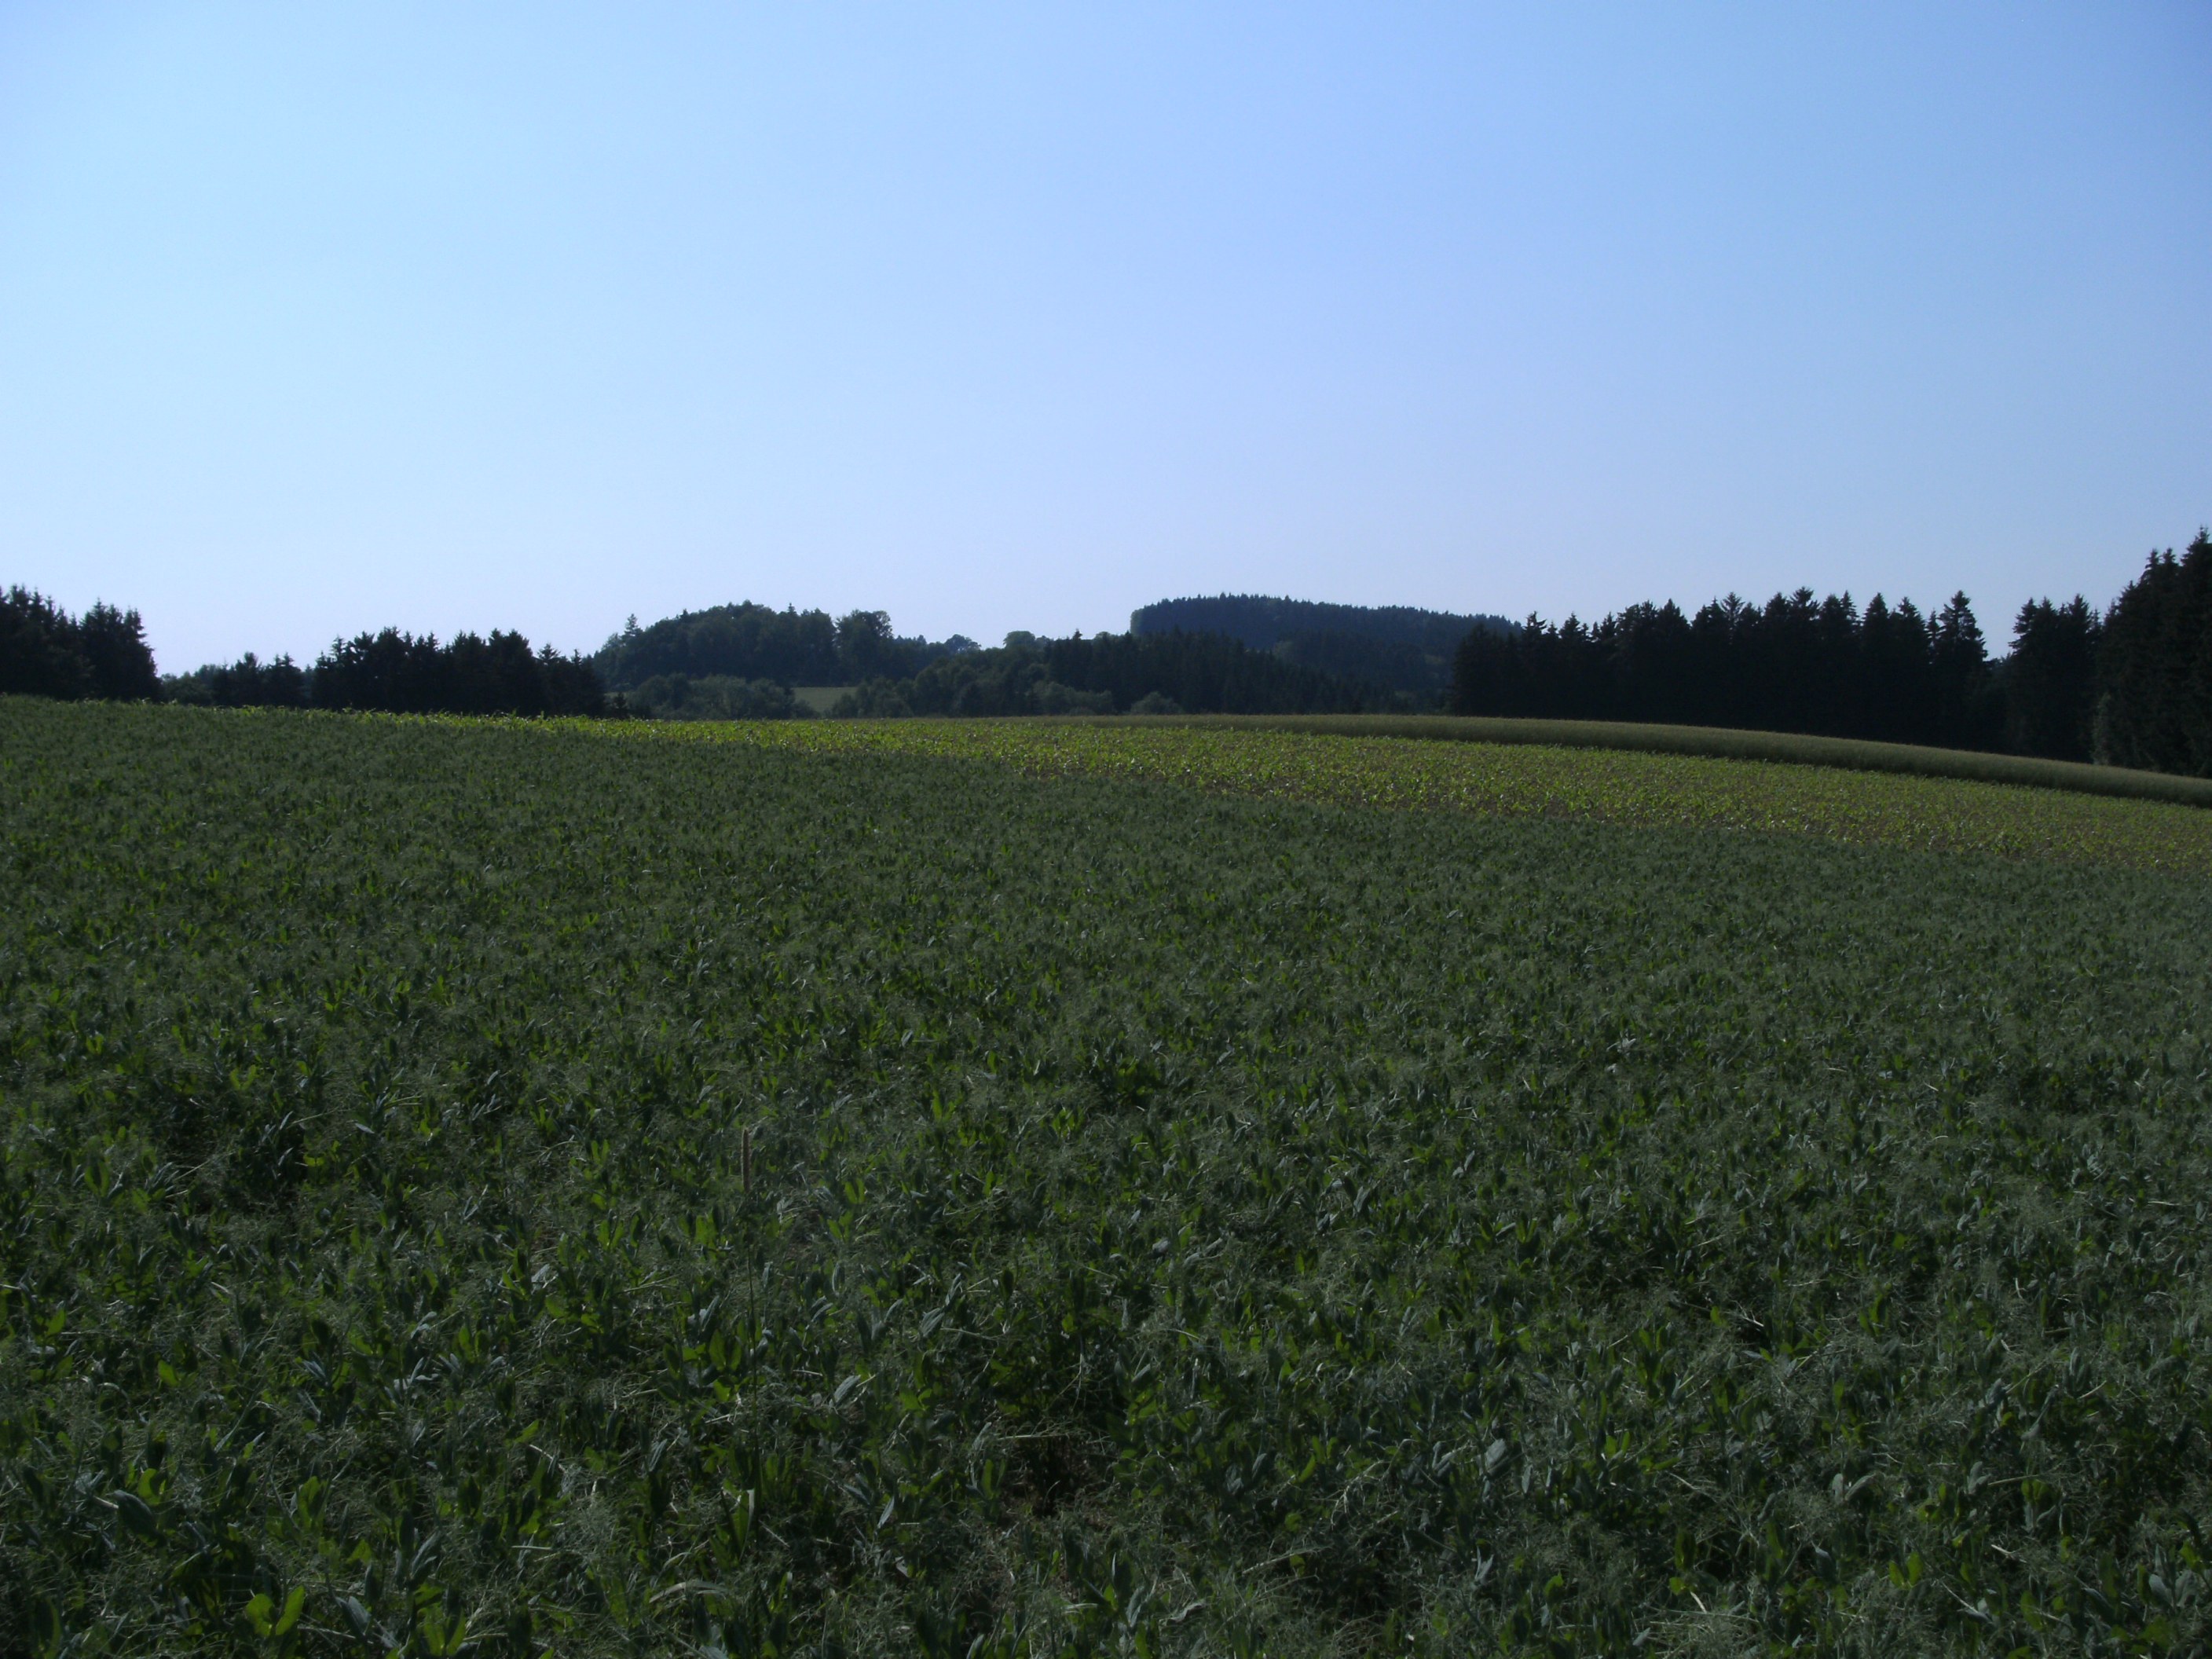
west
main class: Cropland
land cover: Rye
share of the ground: > 75 %
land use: Agriculture (excluding fallow land and kitchen gardens)
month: June
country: AT
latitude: 48.3968
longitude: 14.1736
